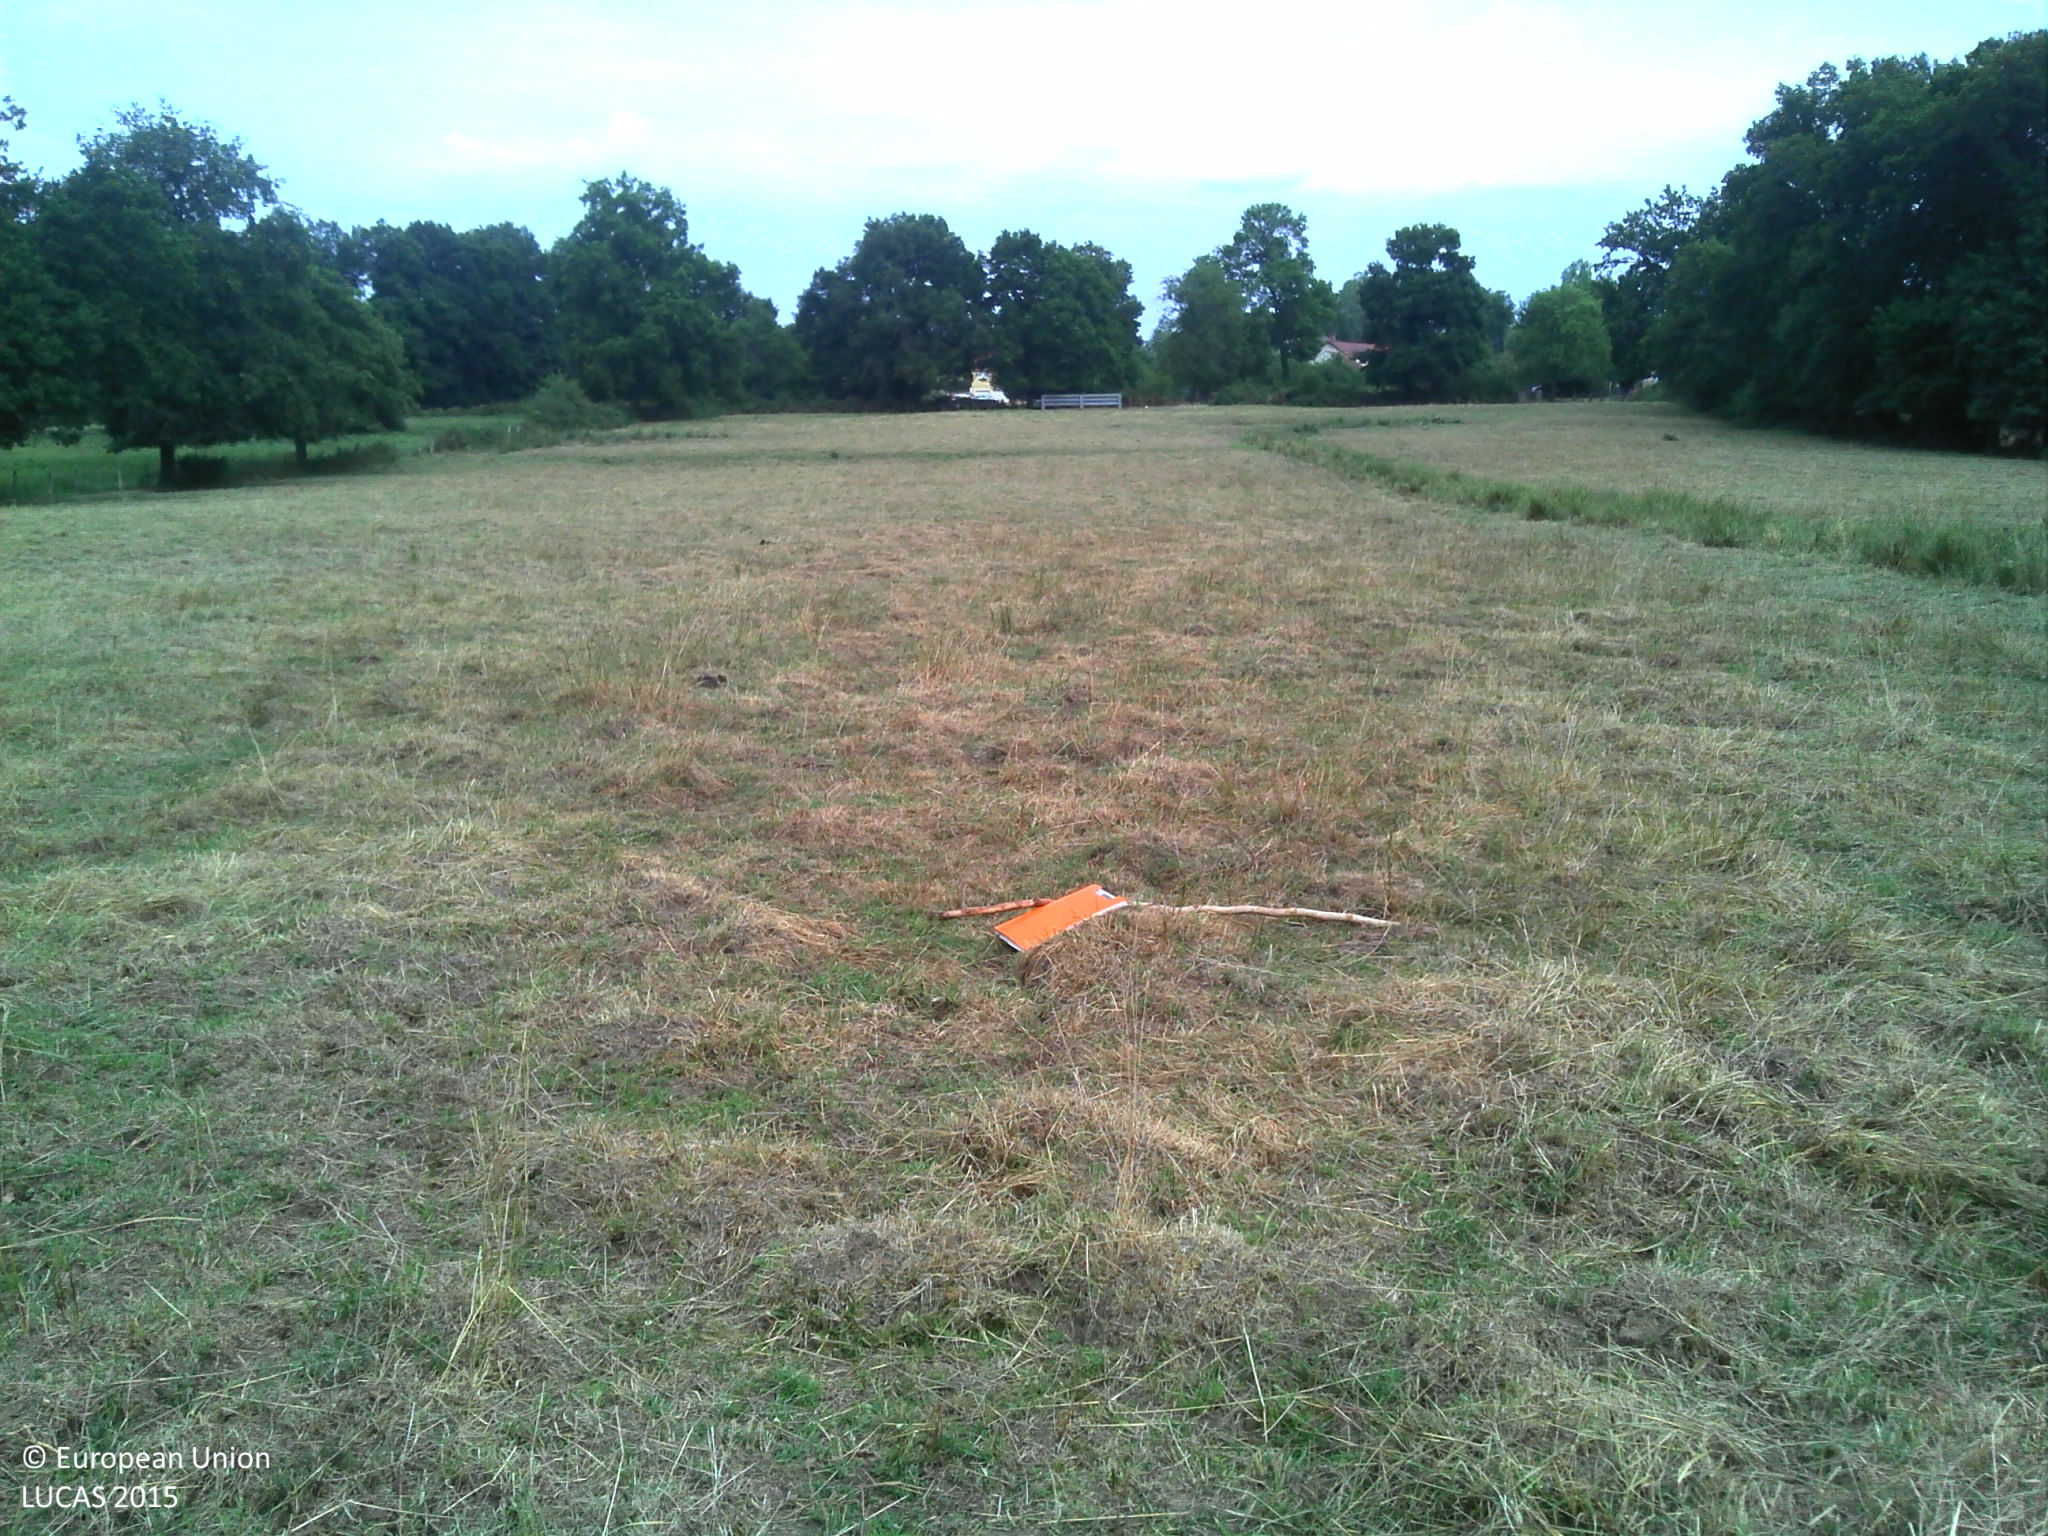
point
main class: Grassland
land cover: Grassland without tree/shrub cover
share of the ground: > 75 %
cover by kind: herbaceous plants 100 %
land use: Agriculture (excluding fallow land and kitchen gardens)
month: August
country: FR
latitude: 46.2696
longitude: 3.6289
